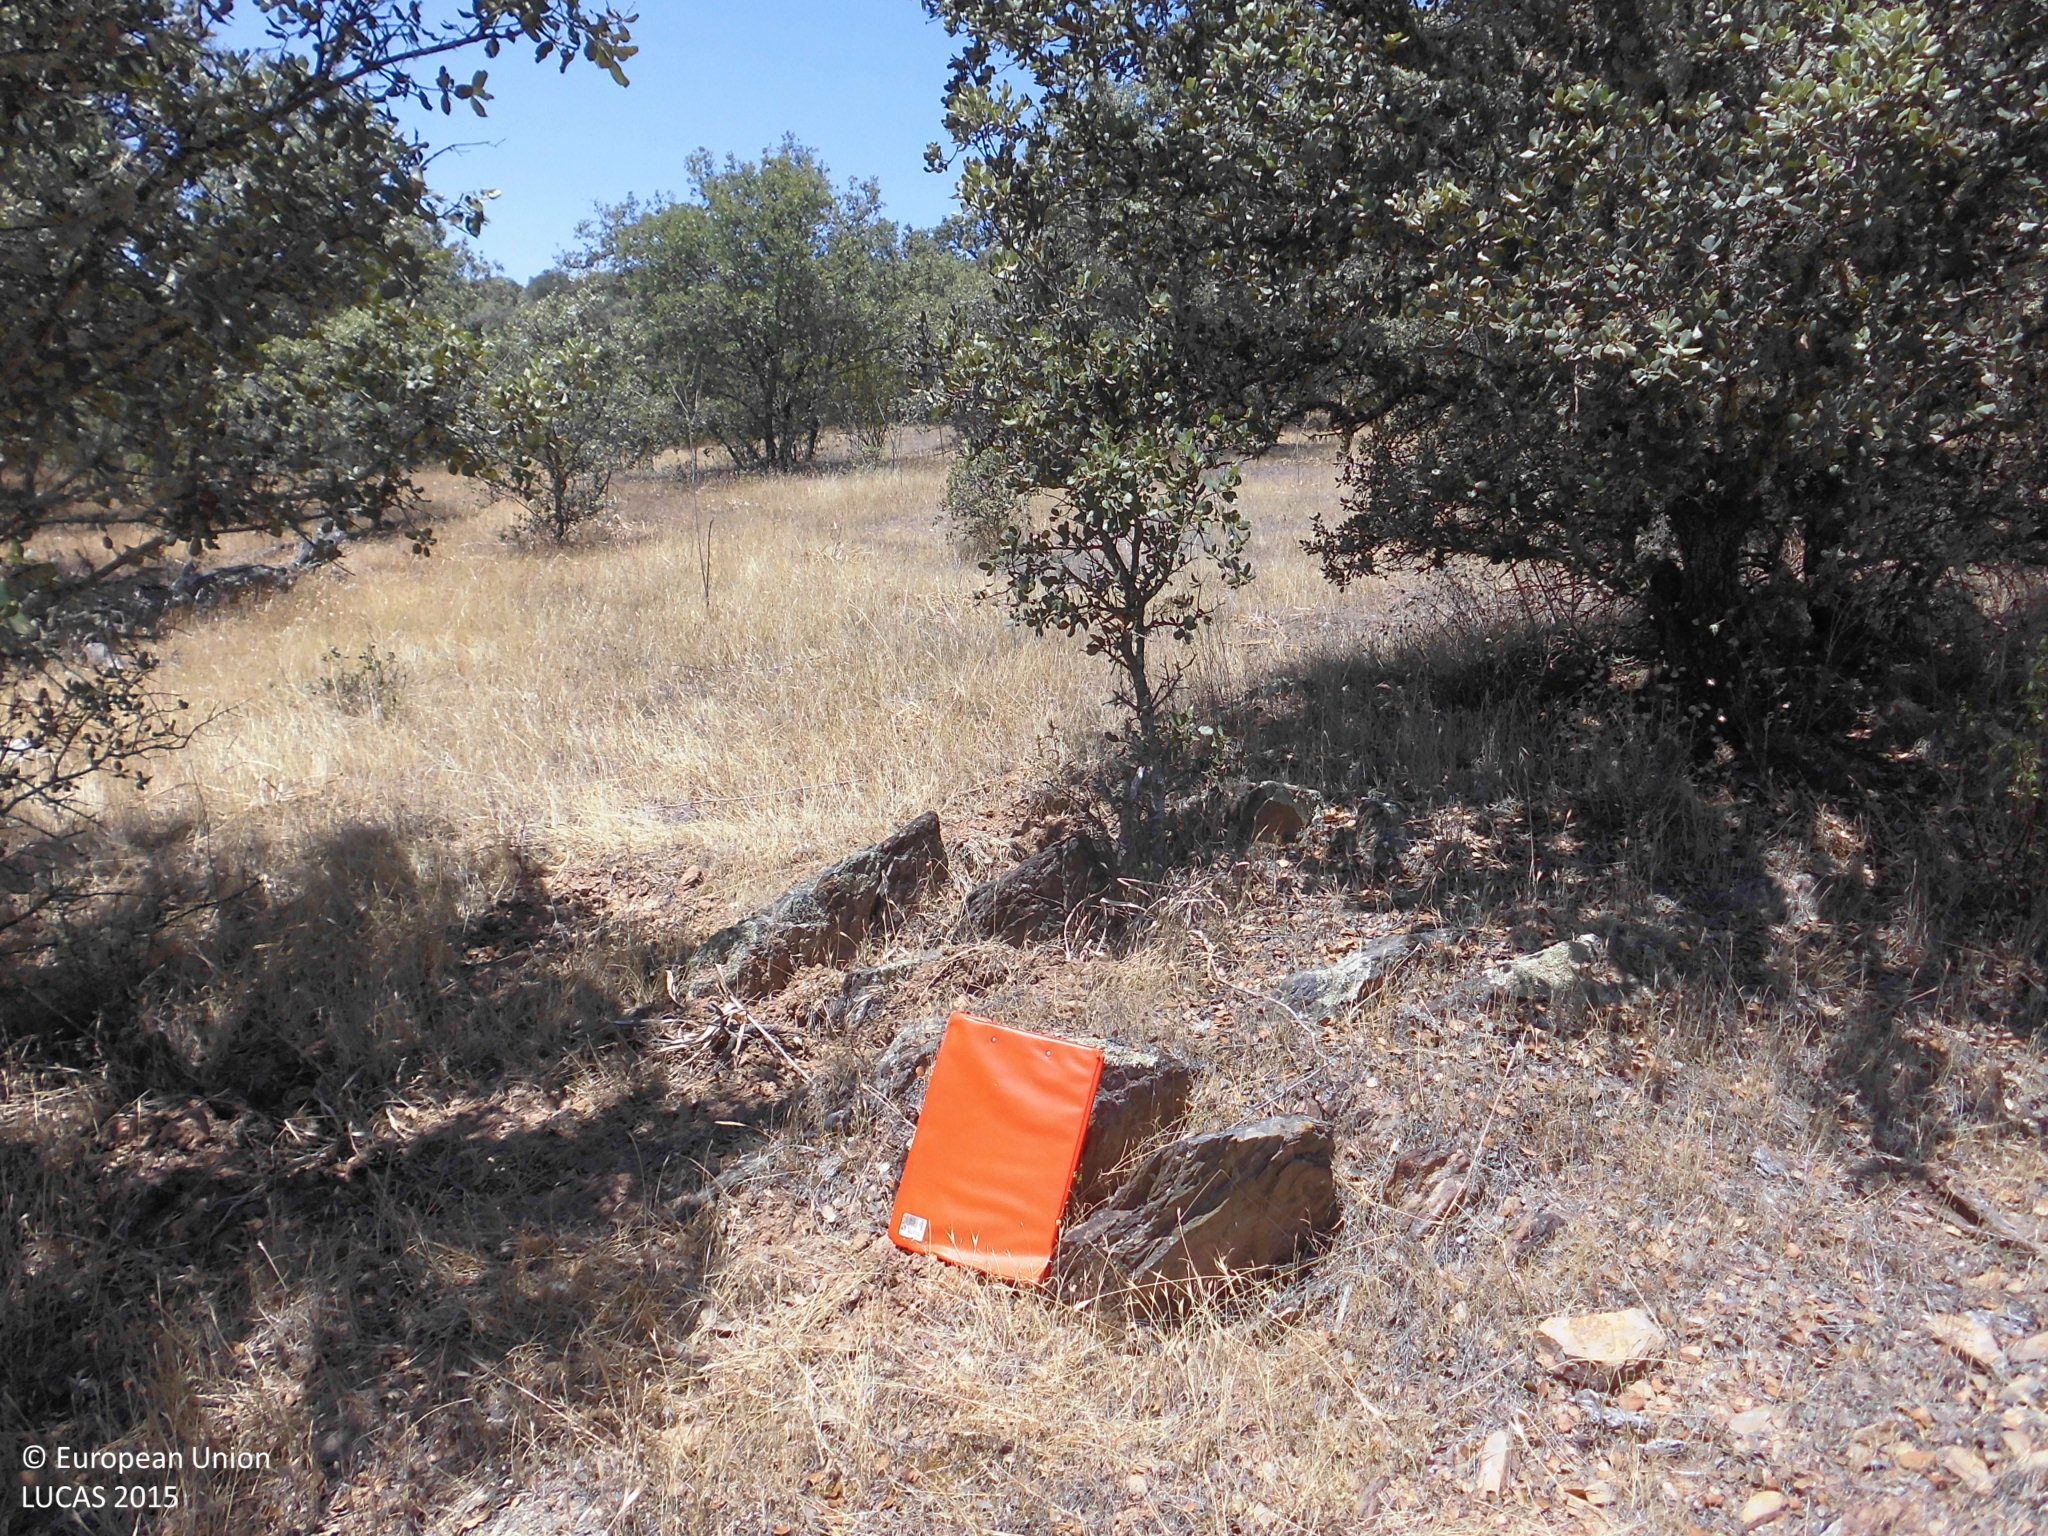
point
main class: Woodland
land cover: Broadleaved woodland
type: broadleaved evergreen forest
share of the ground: 50 - 75 %
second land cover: Grassland without tree/shrub cover
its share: > 75 %
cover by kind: broadleaved forest trees 50 %, herbaceous plants 50 %
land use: Semi-natural and natural areas not in use
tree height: > 5 m
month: June
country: ES
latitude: 39.6551
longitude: -6.0433
